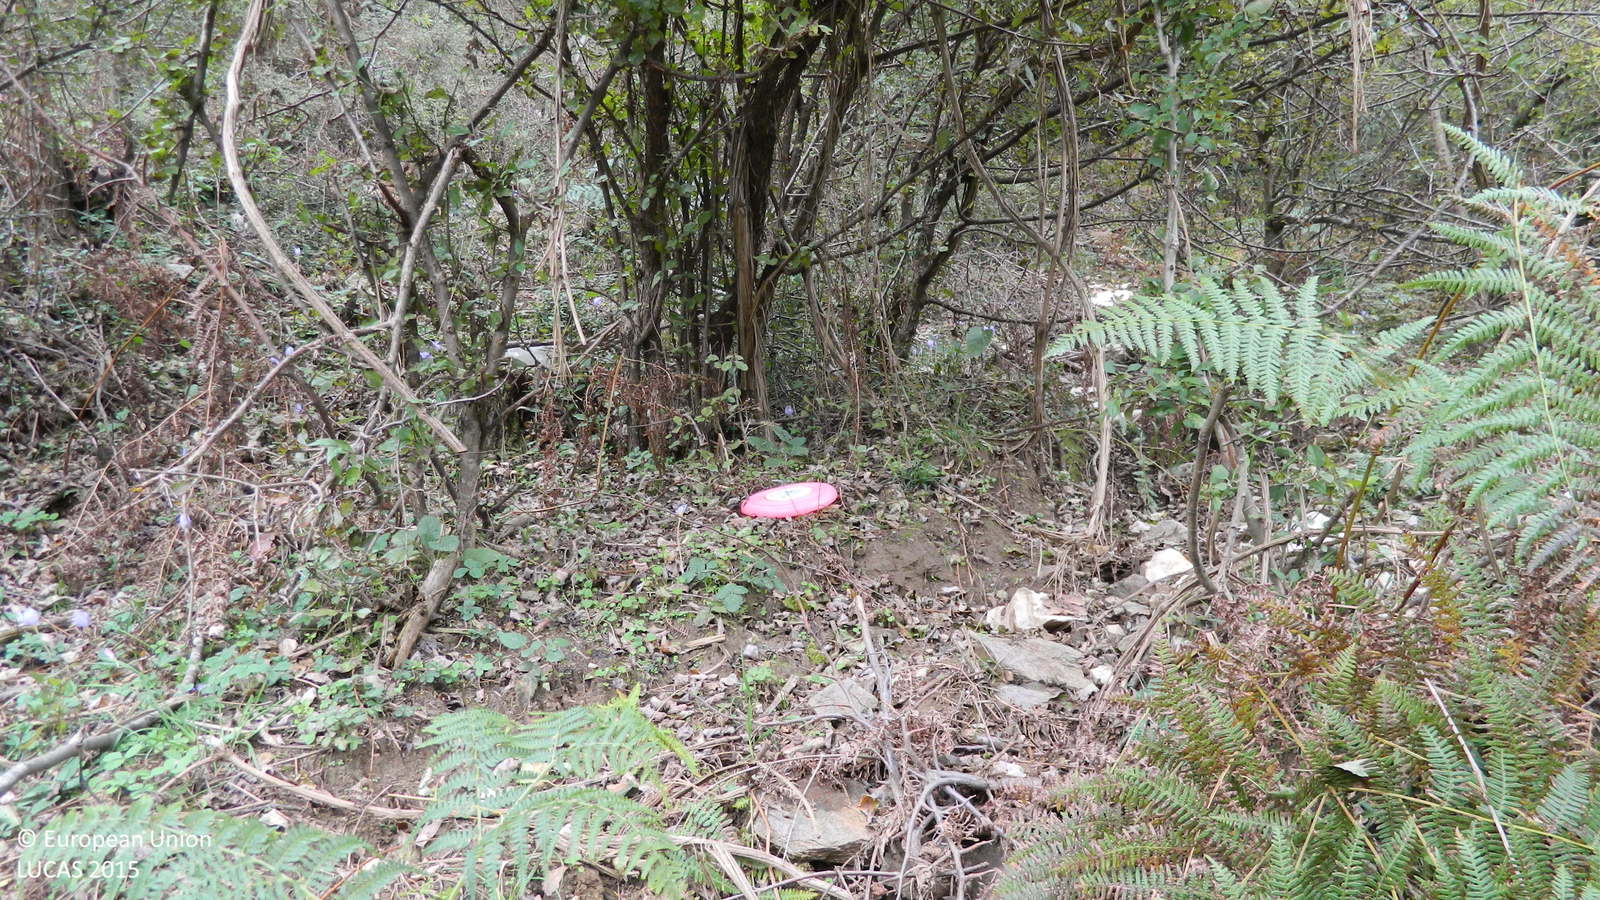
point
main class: Woodland
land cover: Broadleaved woodland
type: mesophytic deciduous forest
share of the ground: > 75 %
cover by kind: broadleaved forest trees 75 %, shrubs 15 %, herbaceous plants 5 %, unconsolidated bare surface 5 %
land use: Forestry
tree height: > 5 m
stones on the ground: < 10 %
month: October
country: BG
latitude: 41.3107
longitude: 25.2317
